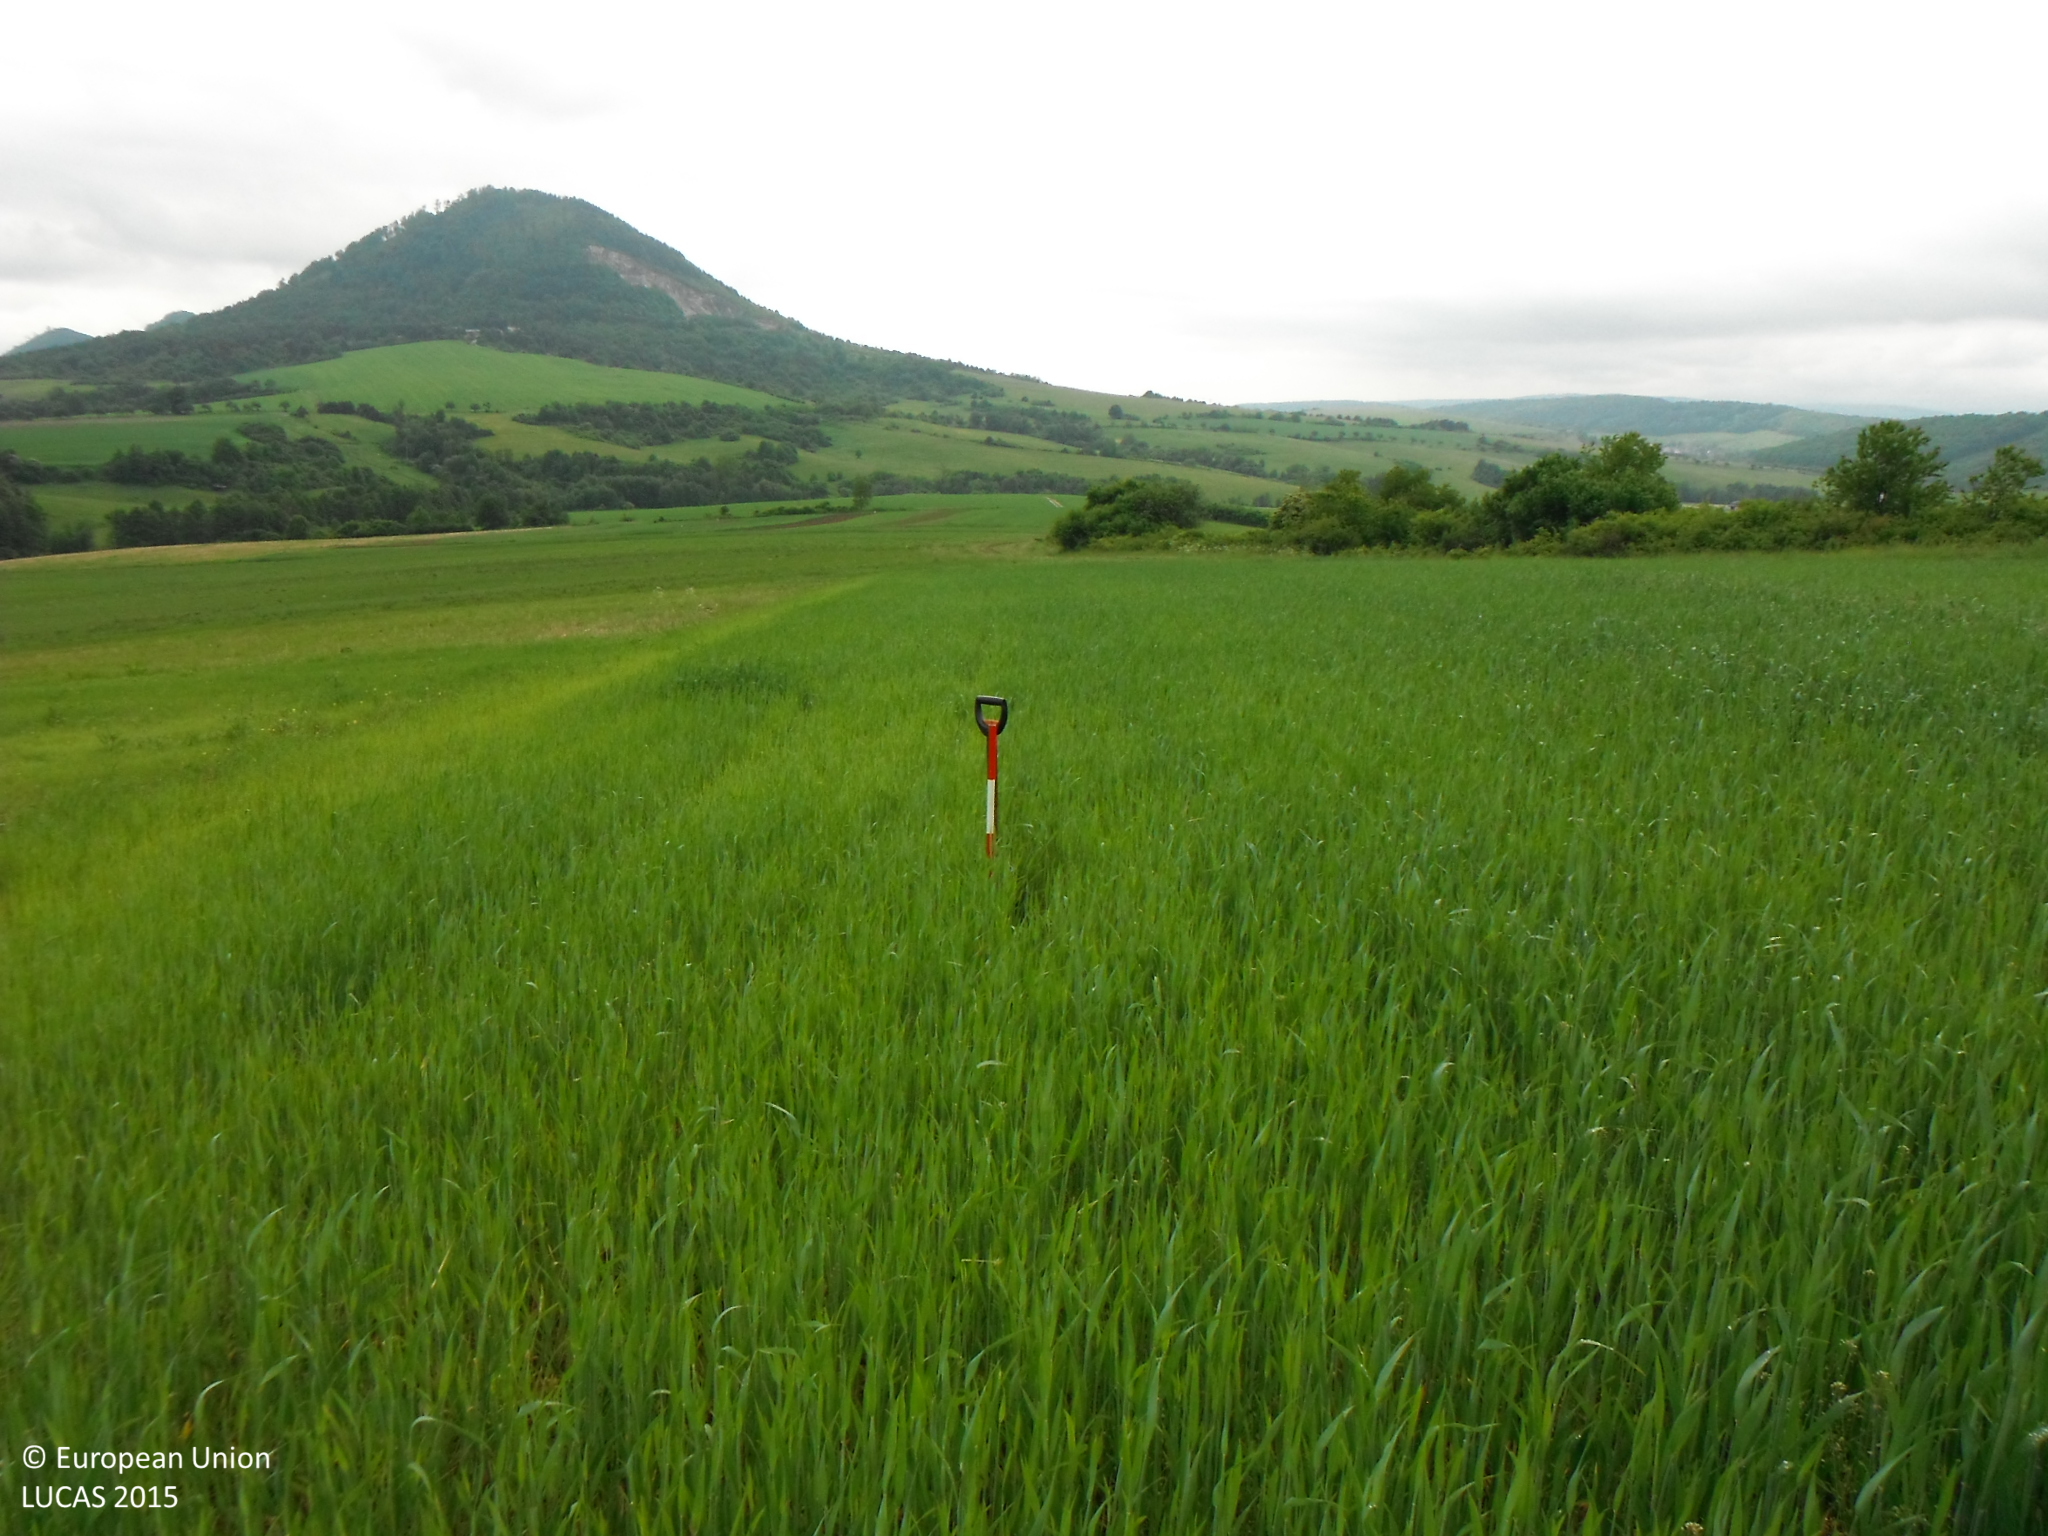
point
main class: Cropland
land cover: Common wheat
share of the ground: > 75 %
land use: Agriculture (excluding fallow land and kitchen gardens)
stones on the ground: < 10 %
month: May
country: SK
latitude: 49.1030
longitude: 21.2080
